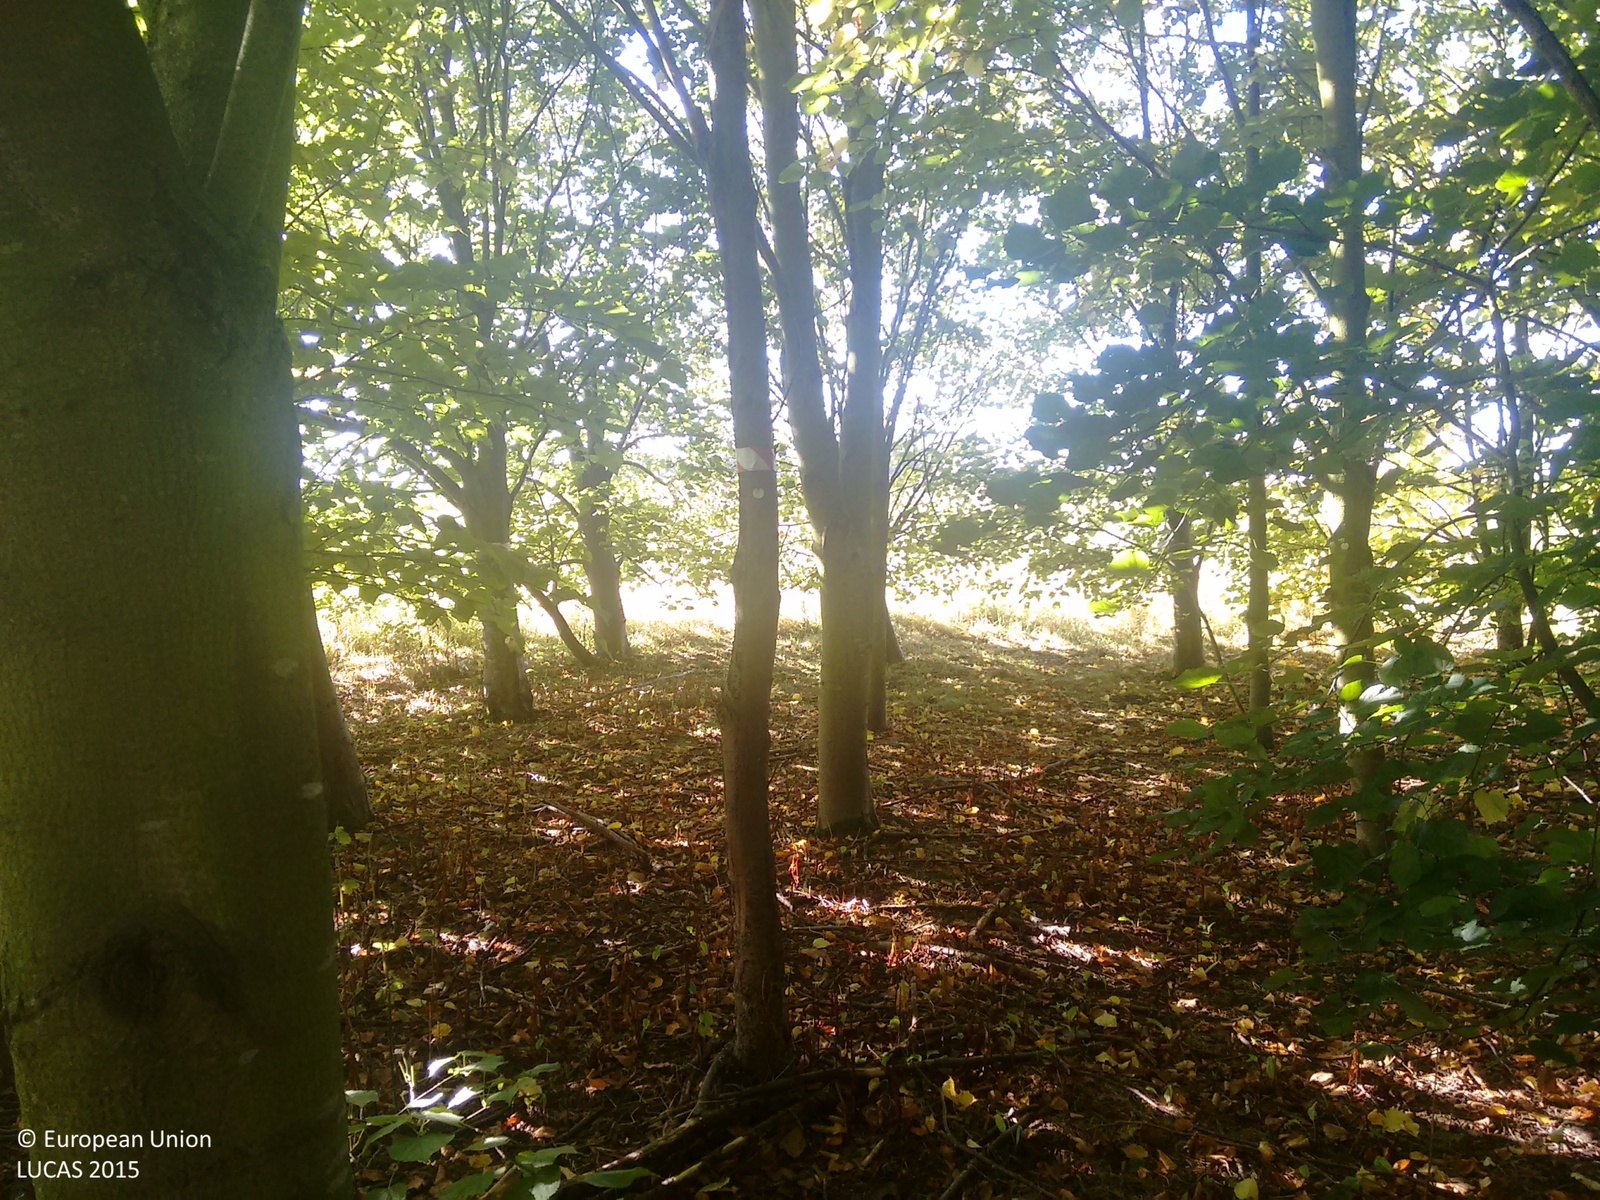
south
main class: Woodland
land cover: Broadleaved woodland
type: mesophytic deciduous forest
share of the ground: > 75 %
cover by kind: broadleaved forest trees 100 %
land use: Forestry
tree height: > 5 m
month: September
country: GB
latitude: 52.2411
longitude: -0.0354
